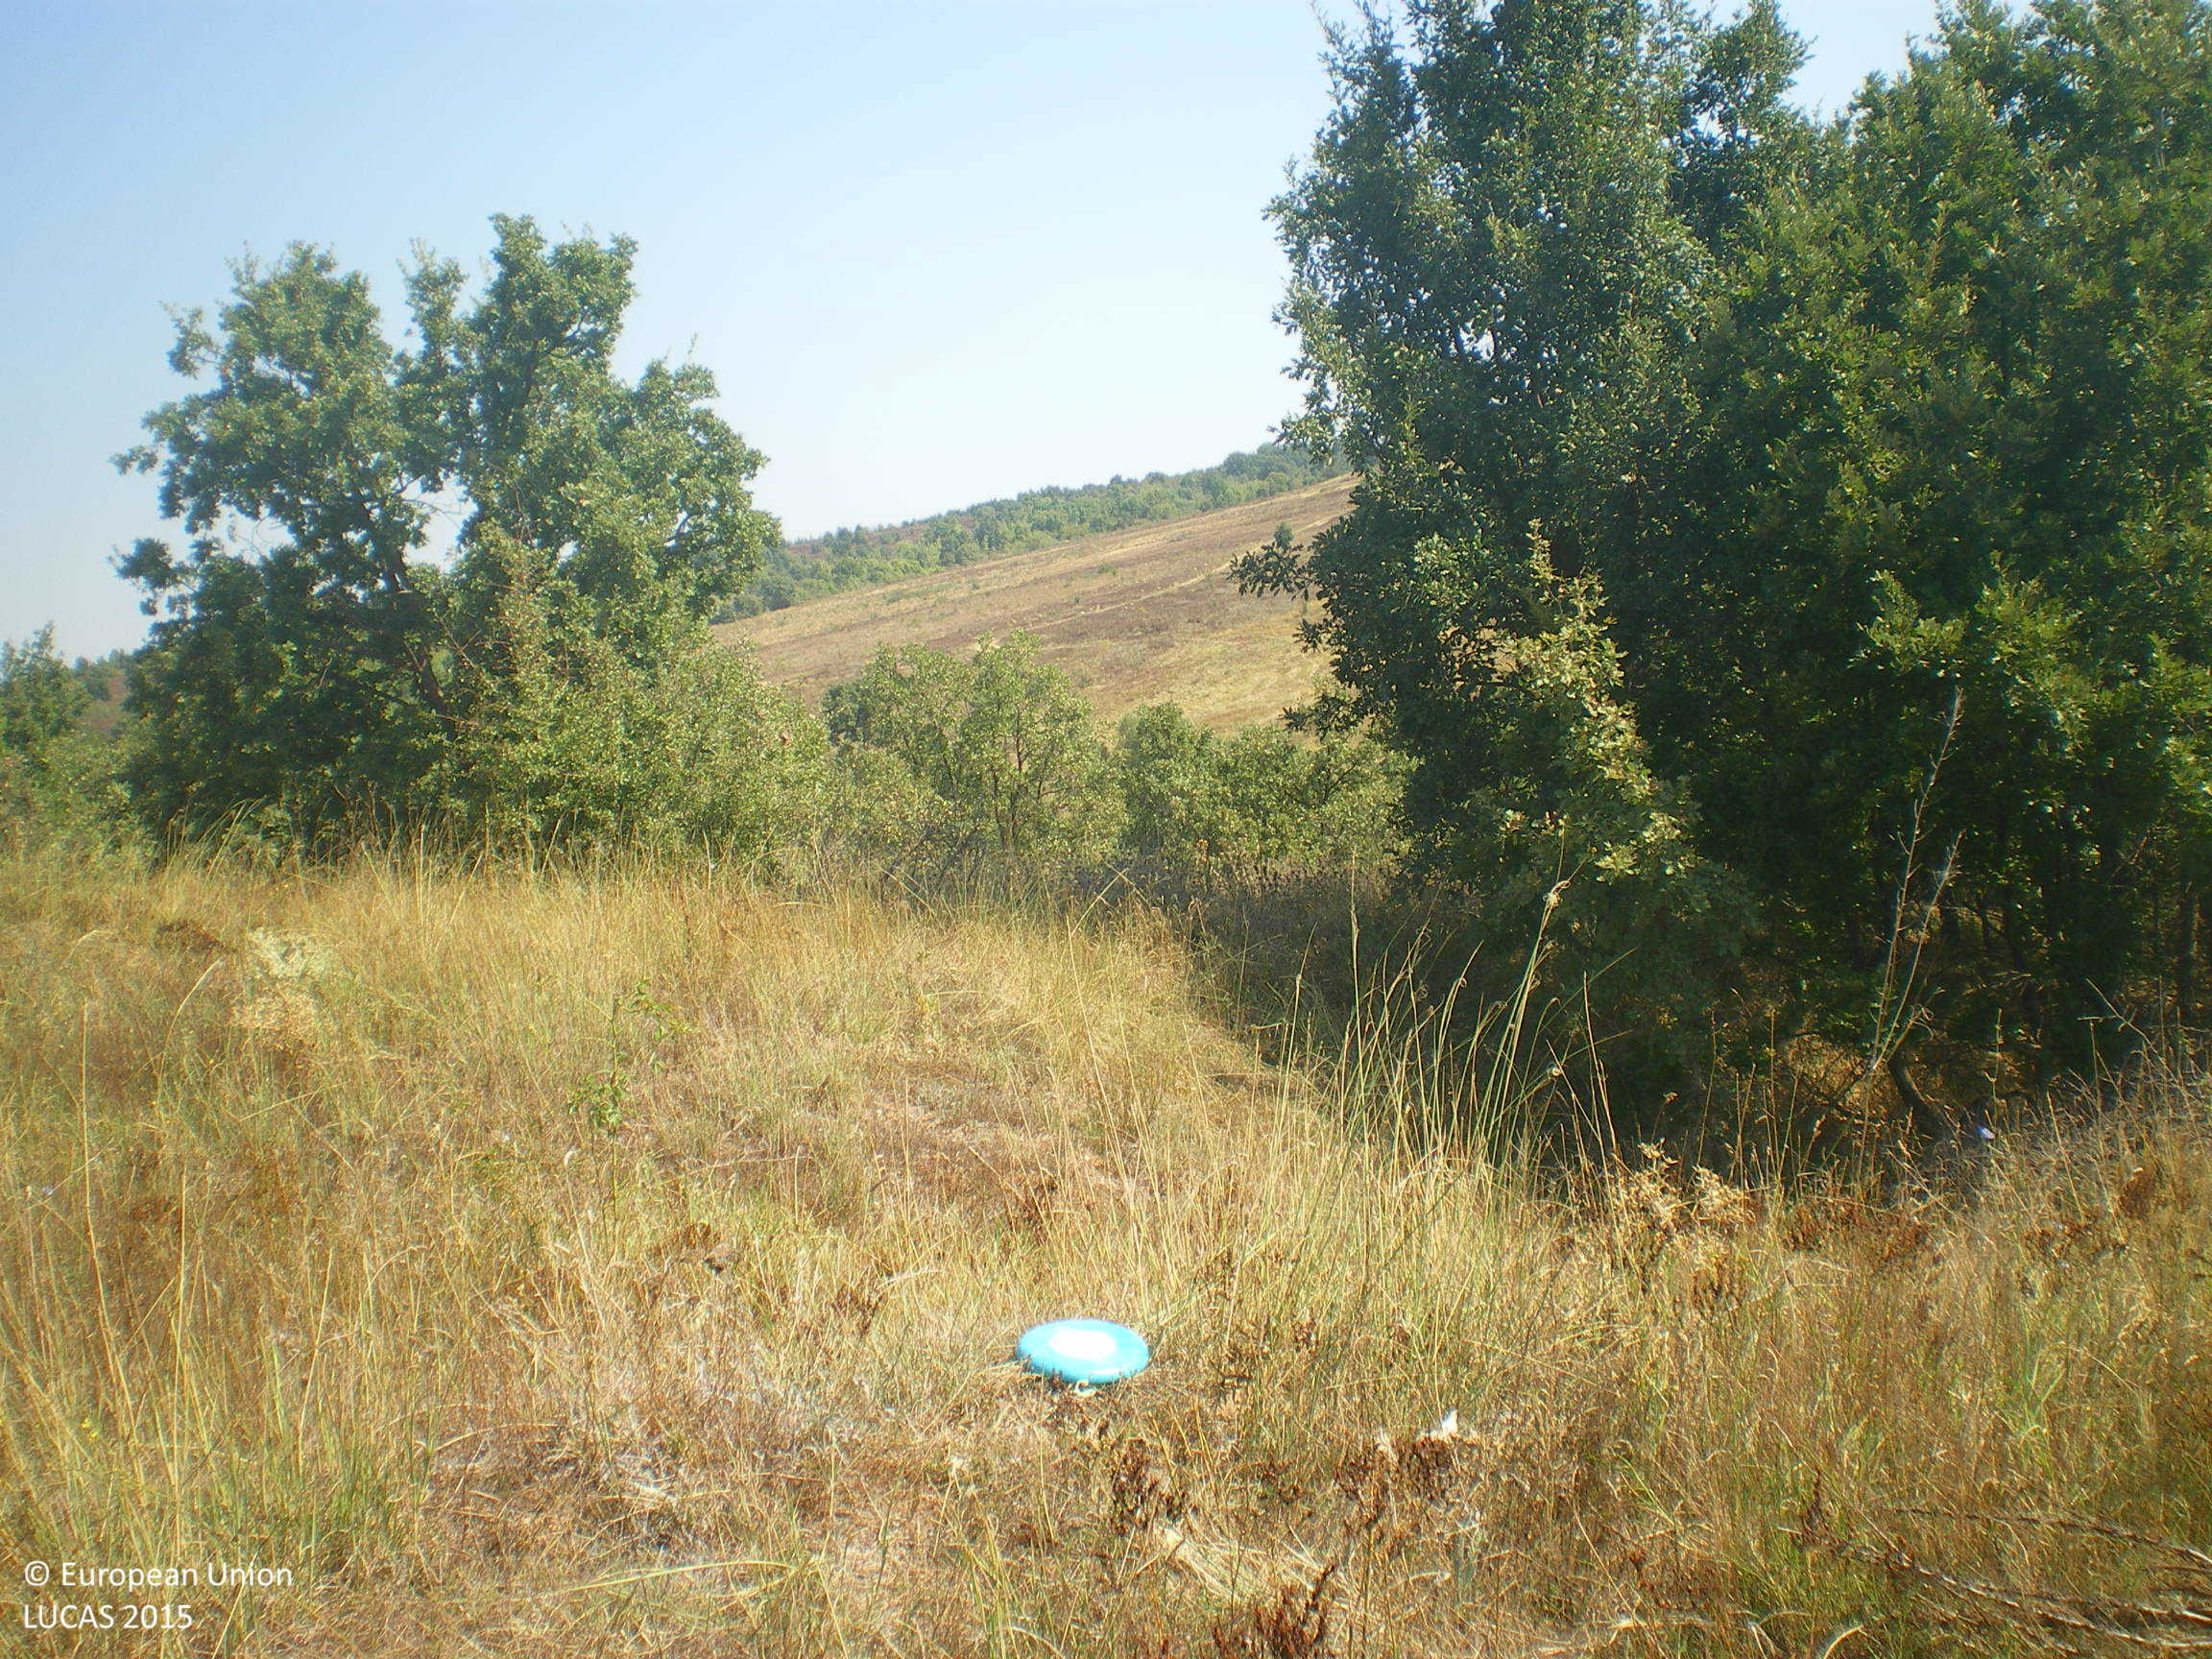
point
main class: Grassland
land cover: Grassland with sparse tree/shrub cover
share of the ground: > 75 %
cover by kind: herbaceous plants 90 %, broadleaved forest trees 5 %, shrubs 5 %
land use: Semi-natural and natural areas not in use
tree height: > 5 m
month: August
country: BG
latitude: 42.0114
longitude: 26.0262
